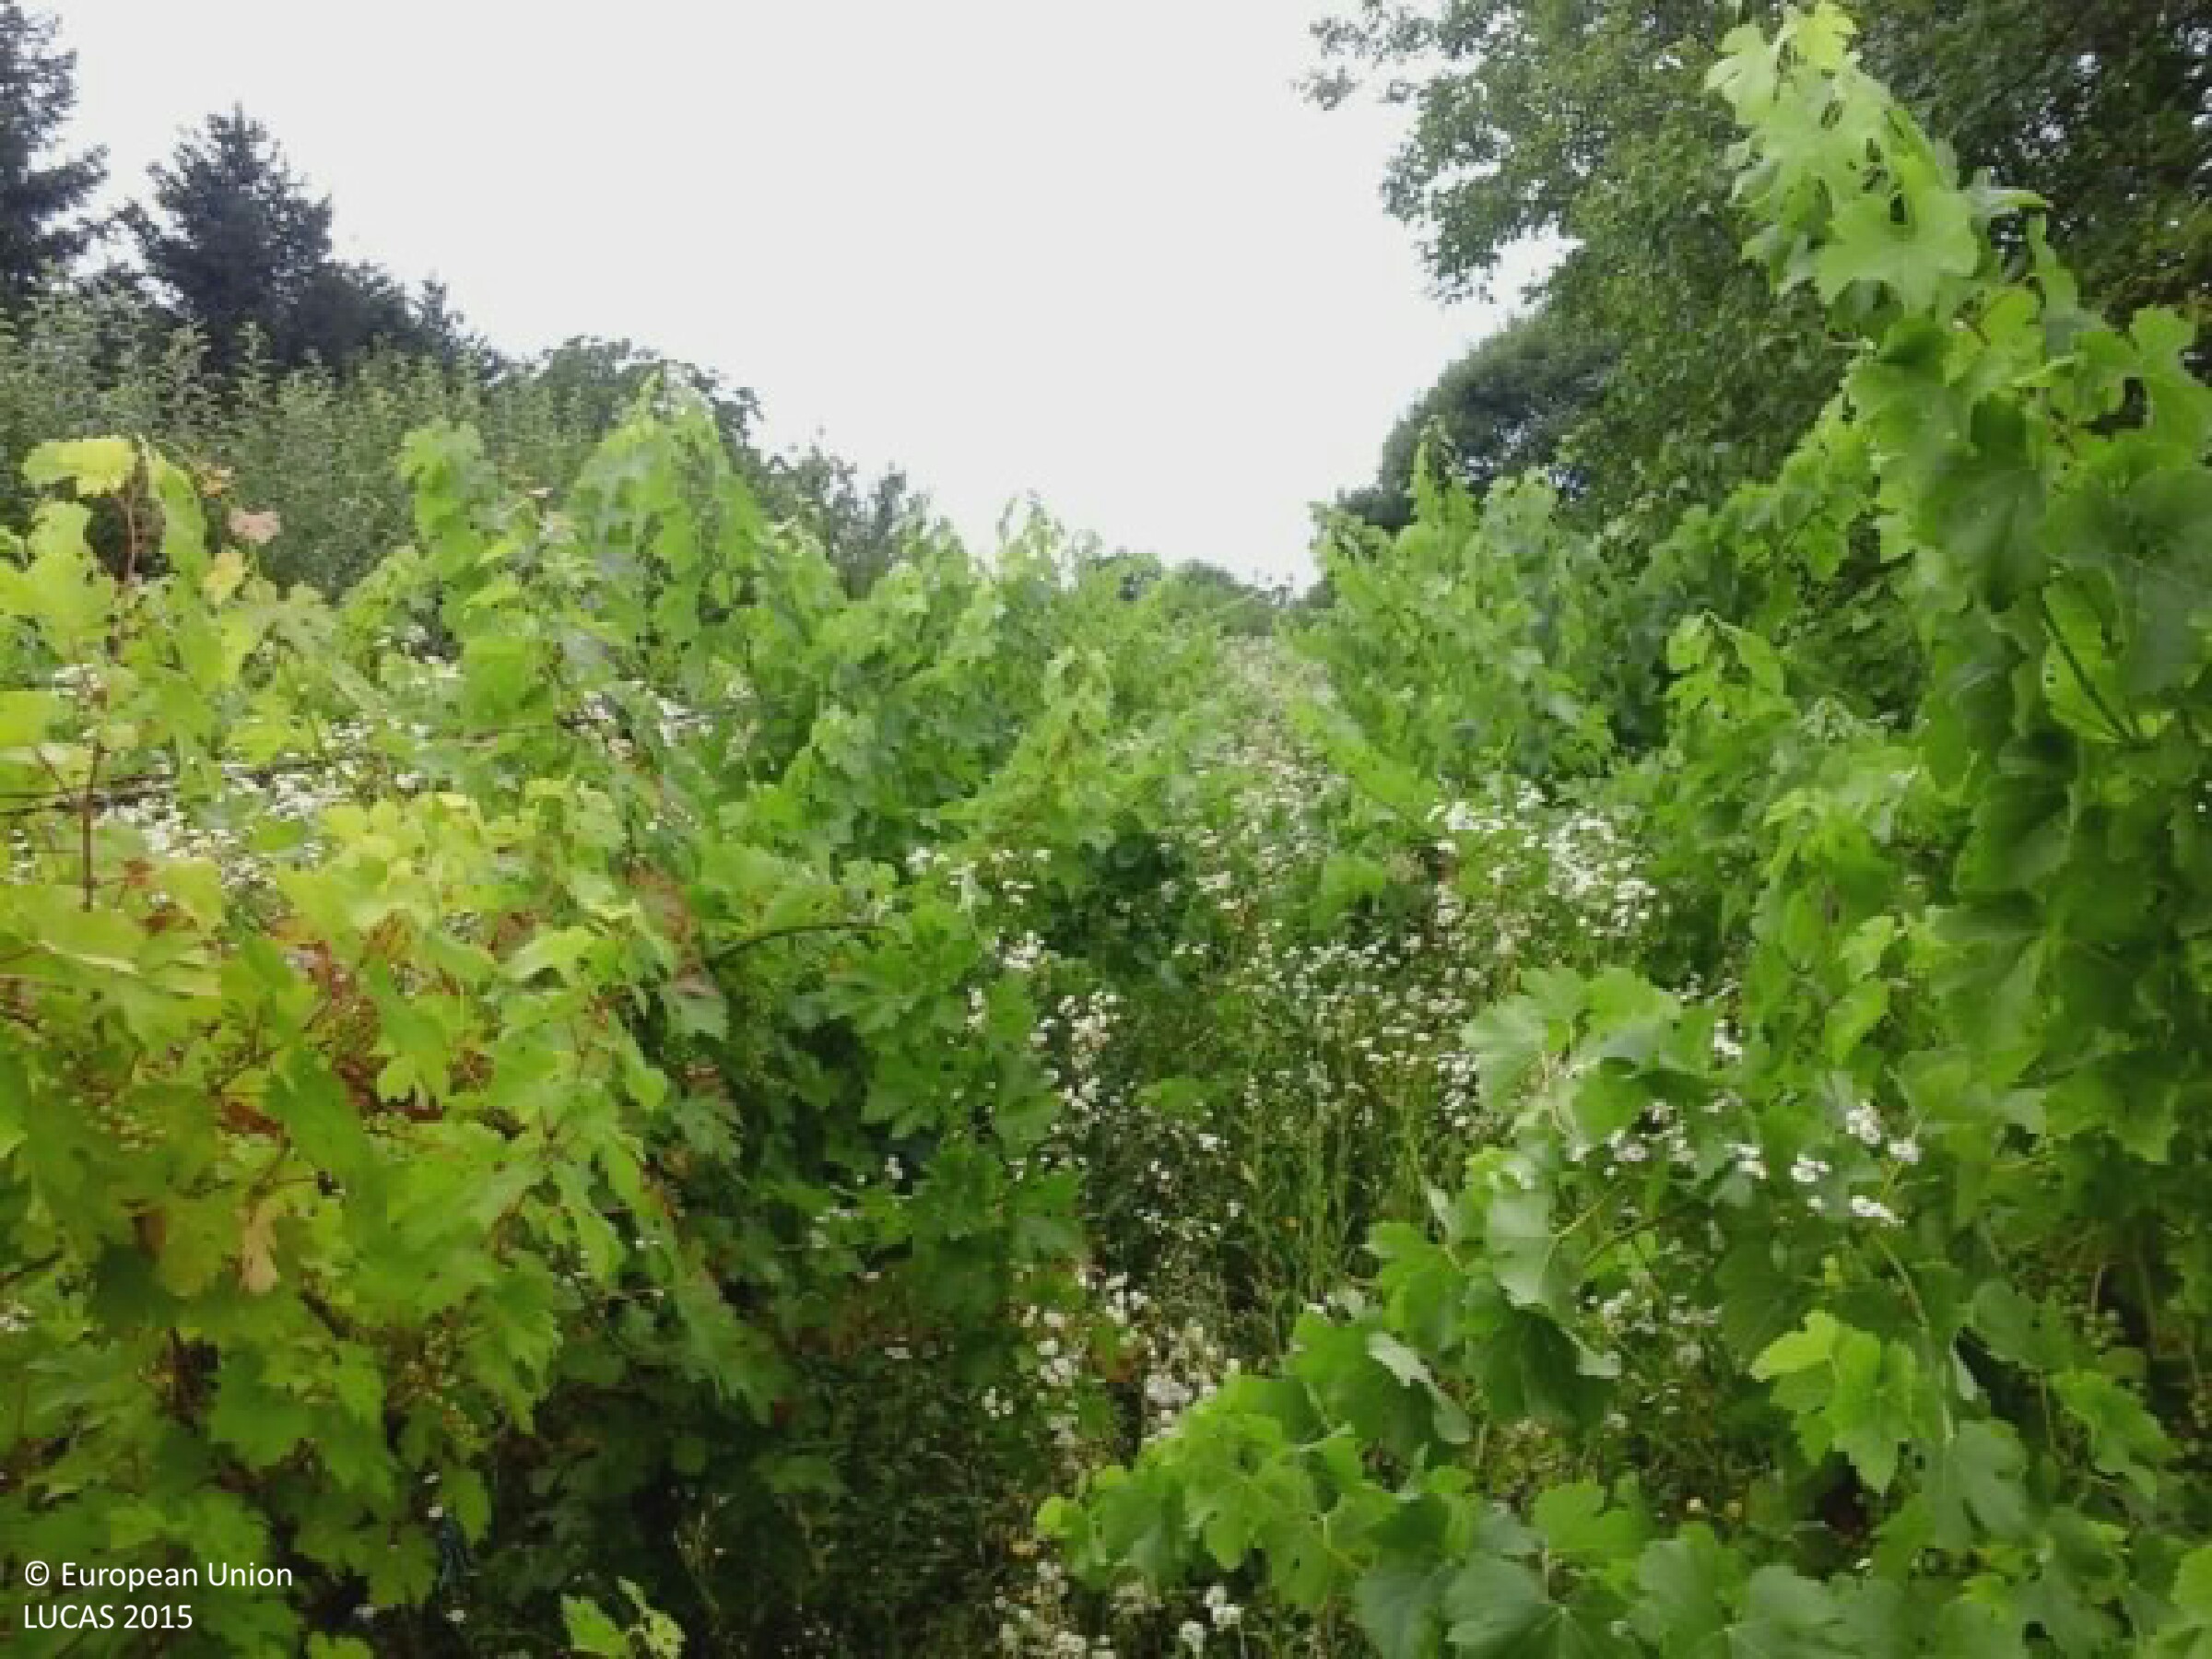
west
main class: Cropland
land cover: Vineyards
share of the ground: 25 - 50 %
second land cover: Spontaneously vegetated surfaces
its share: 50 - 75 %
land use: Abandoned areas
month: July
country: HU
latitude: 46.5124
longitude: 17.1064
